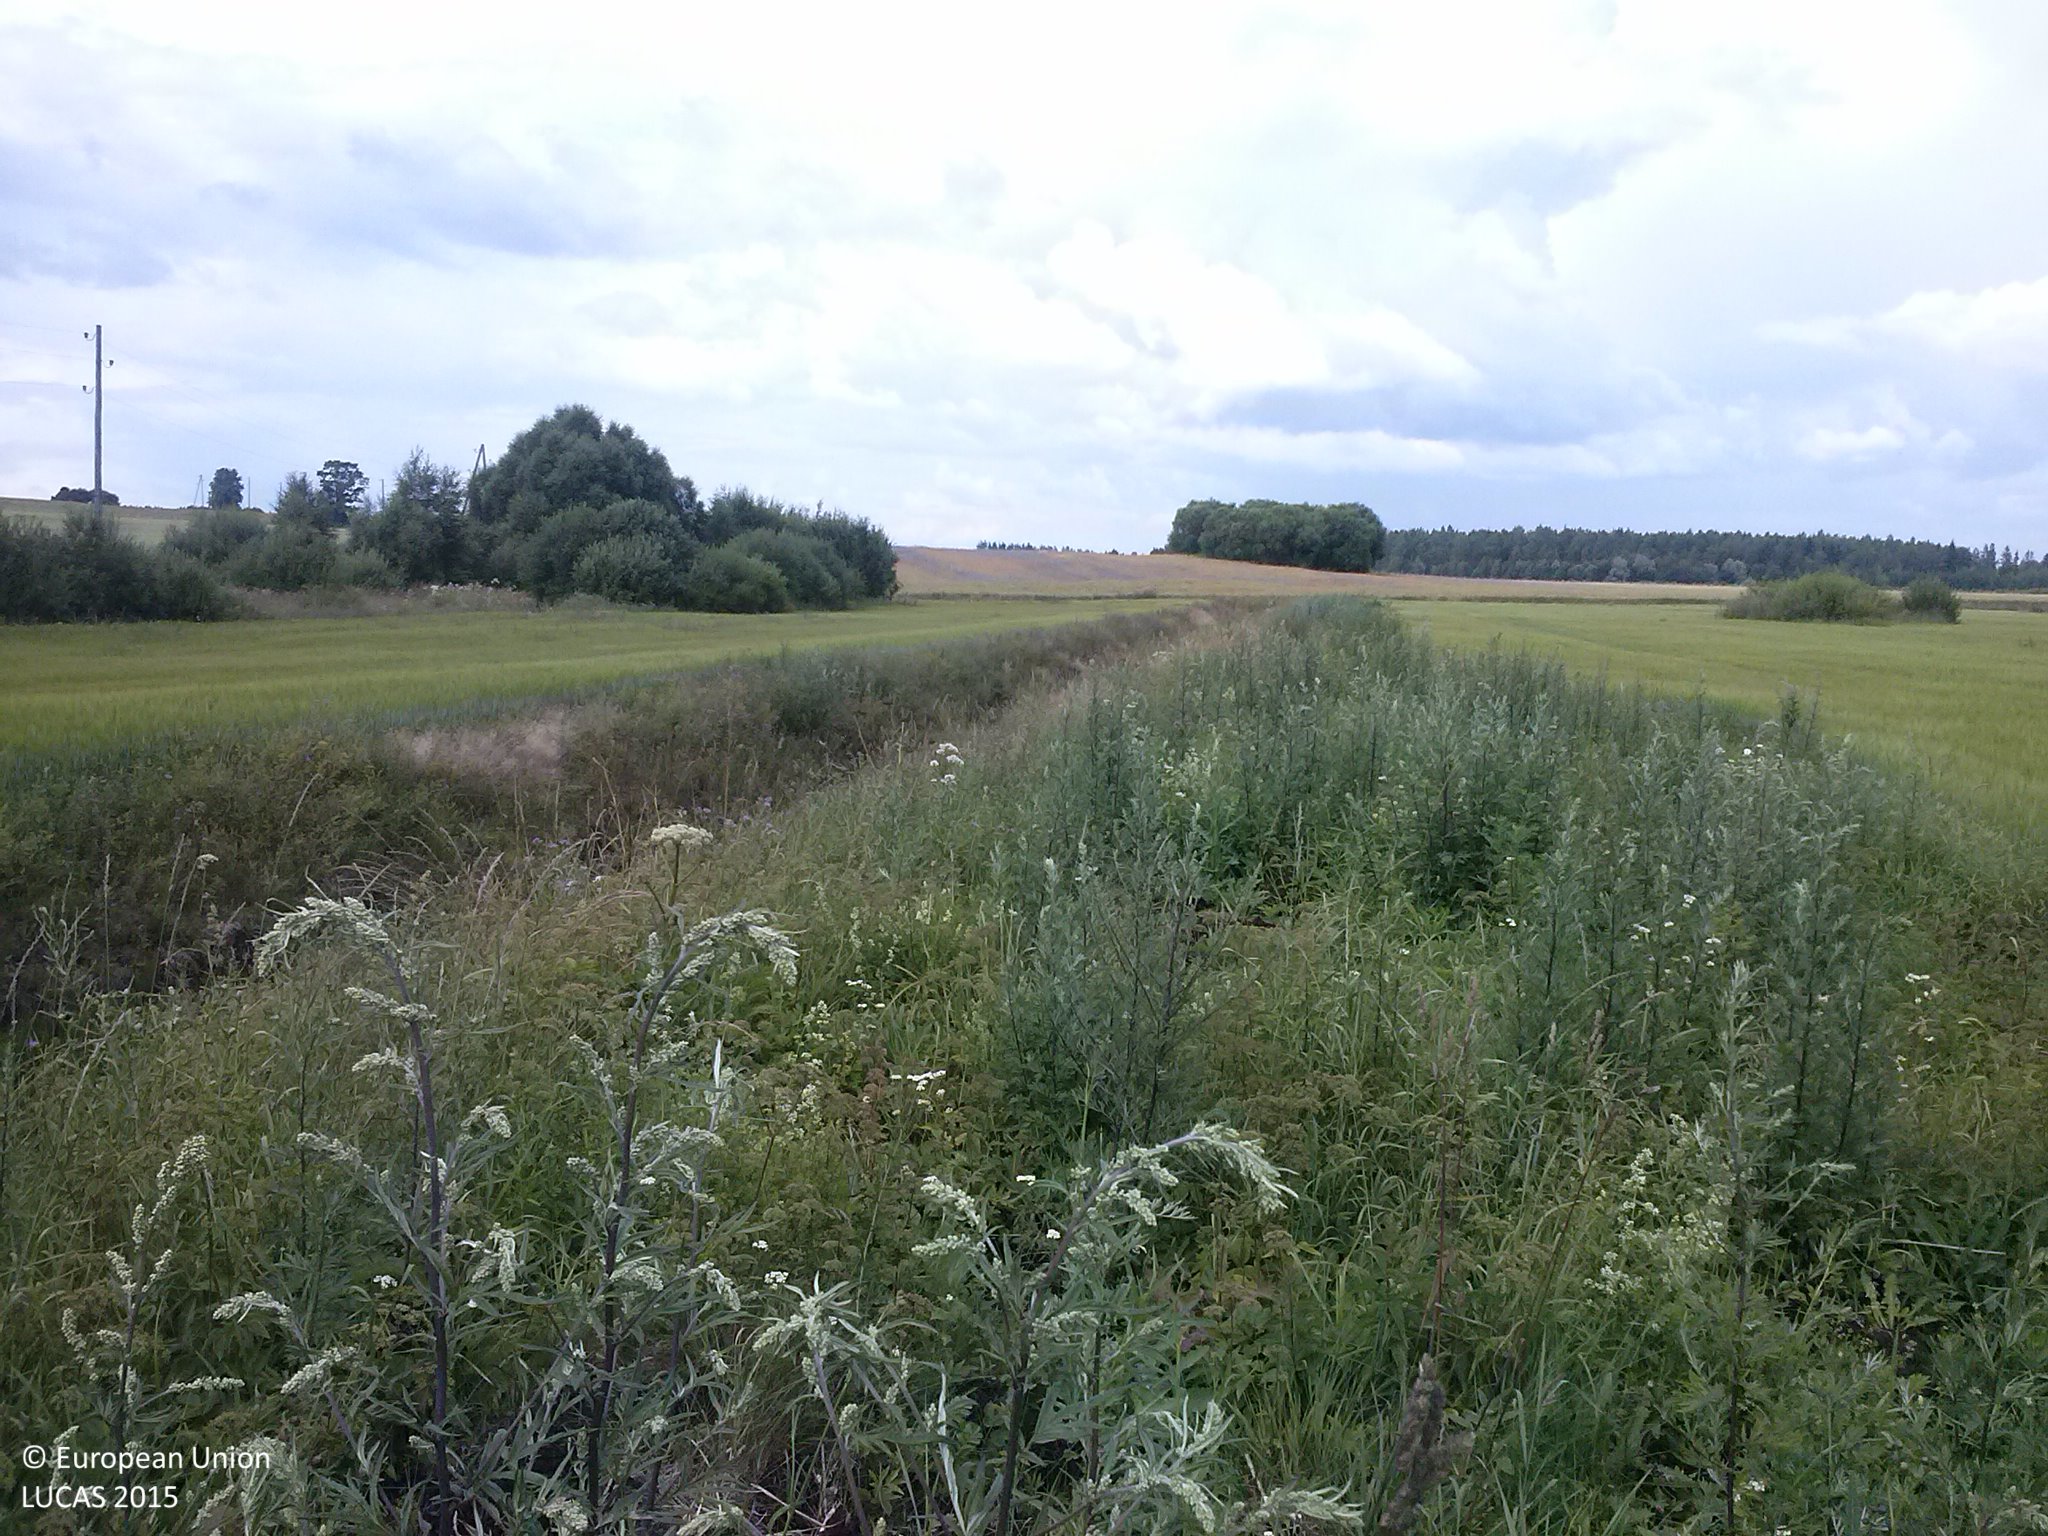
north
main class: Grassland
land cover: Spontaneously vegetated surfaces
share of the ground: > 75 %
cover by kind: herbaceous plants 100 %
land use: Fallow land
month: July
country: LV
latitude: 56.7826
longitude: 27.6129
